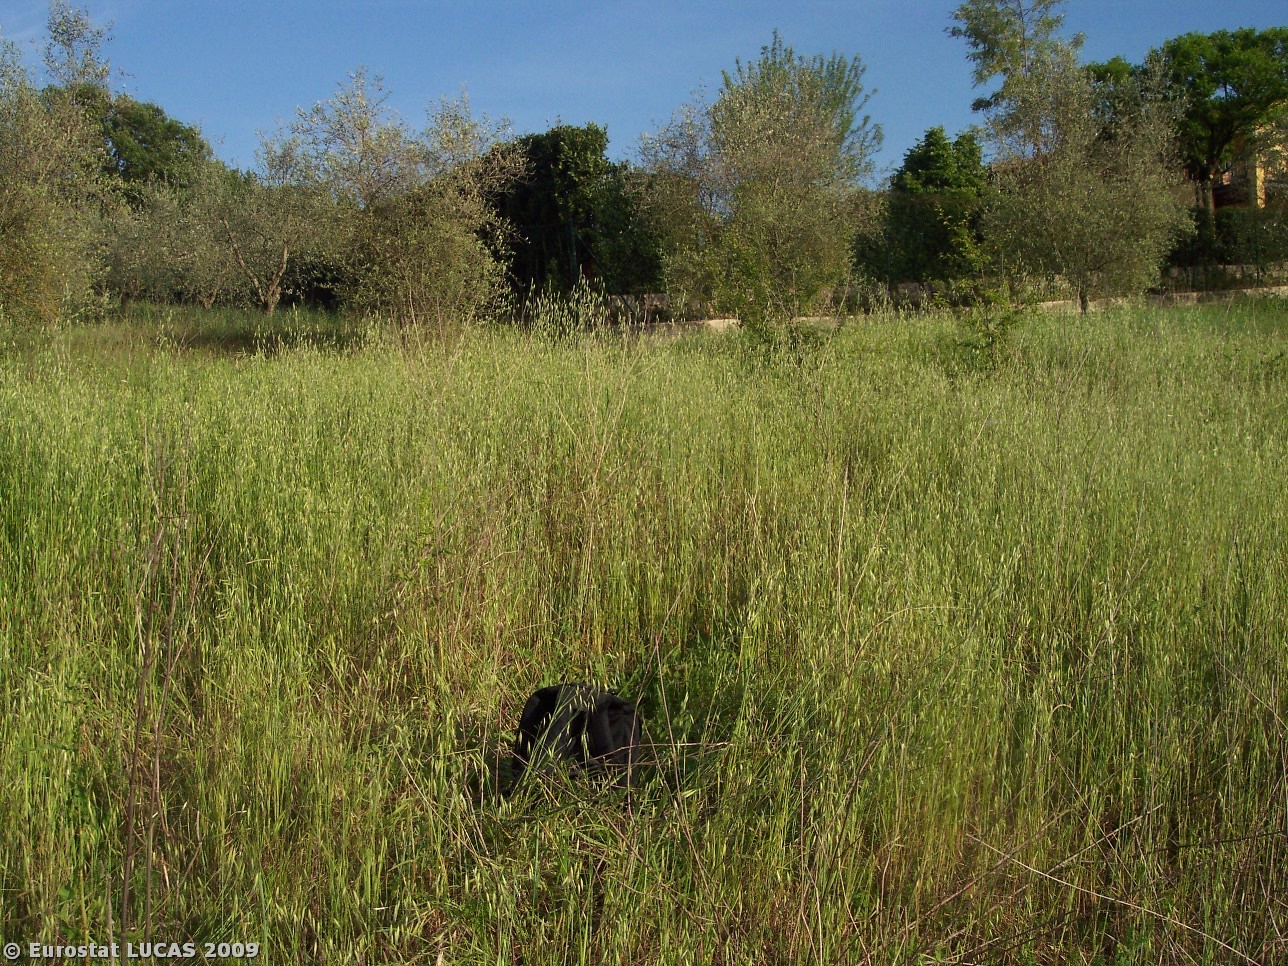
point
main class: Grassland
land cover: Grassland with sparse tree/shrub cover
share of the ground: > 75 %
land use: Agriculture (excluding fallow land and kitchen gardens)
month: May
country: IT
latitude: 43.0775
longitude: 12.3881
